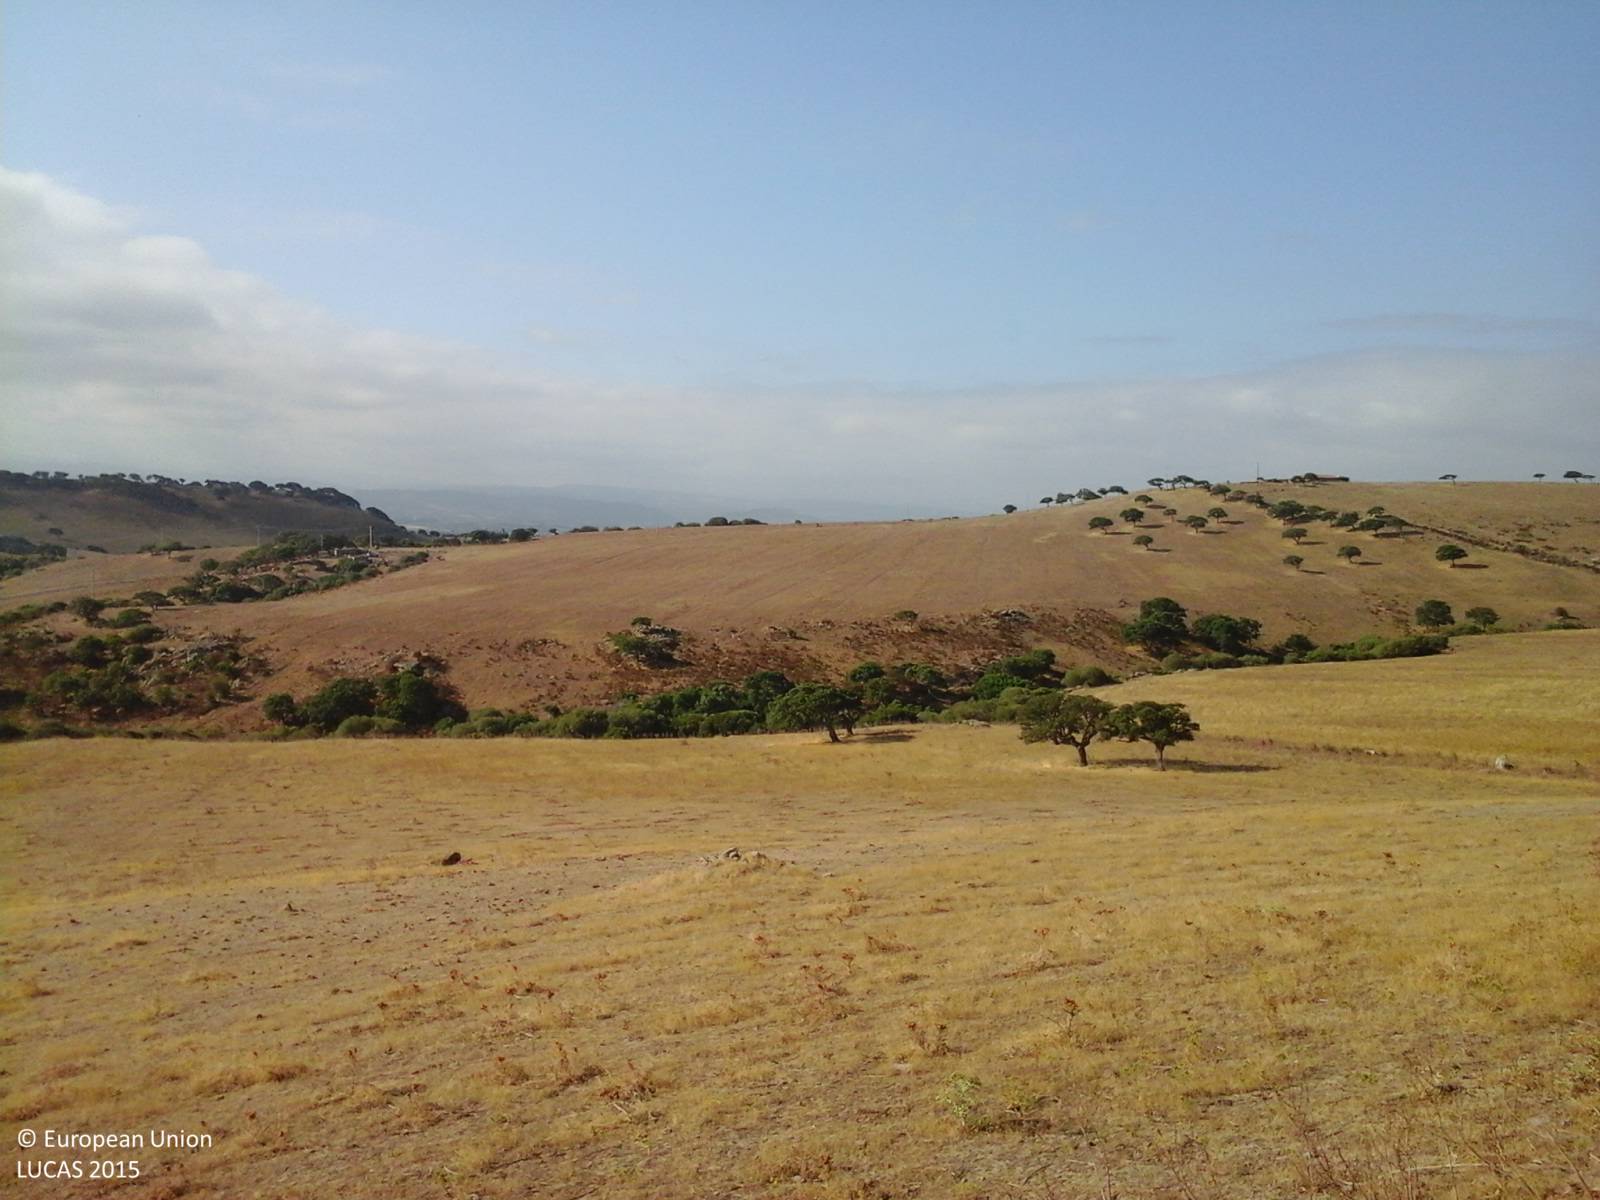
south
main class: Grassland
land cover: Grassland without tree/shrub cover
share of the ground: 10 - 25 %
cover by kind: herbaceous plants 100 %
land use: Agriculture (excluding fallow land and kitchen gardens)
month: July
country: IT
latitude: 40.6594
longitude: 8.9054
